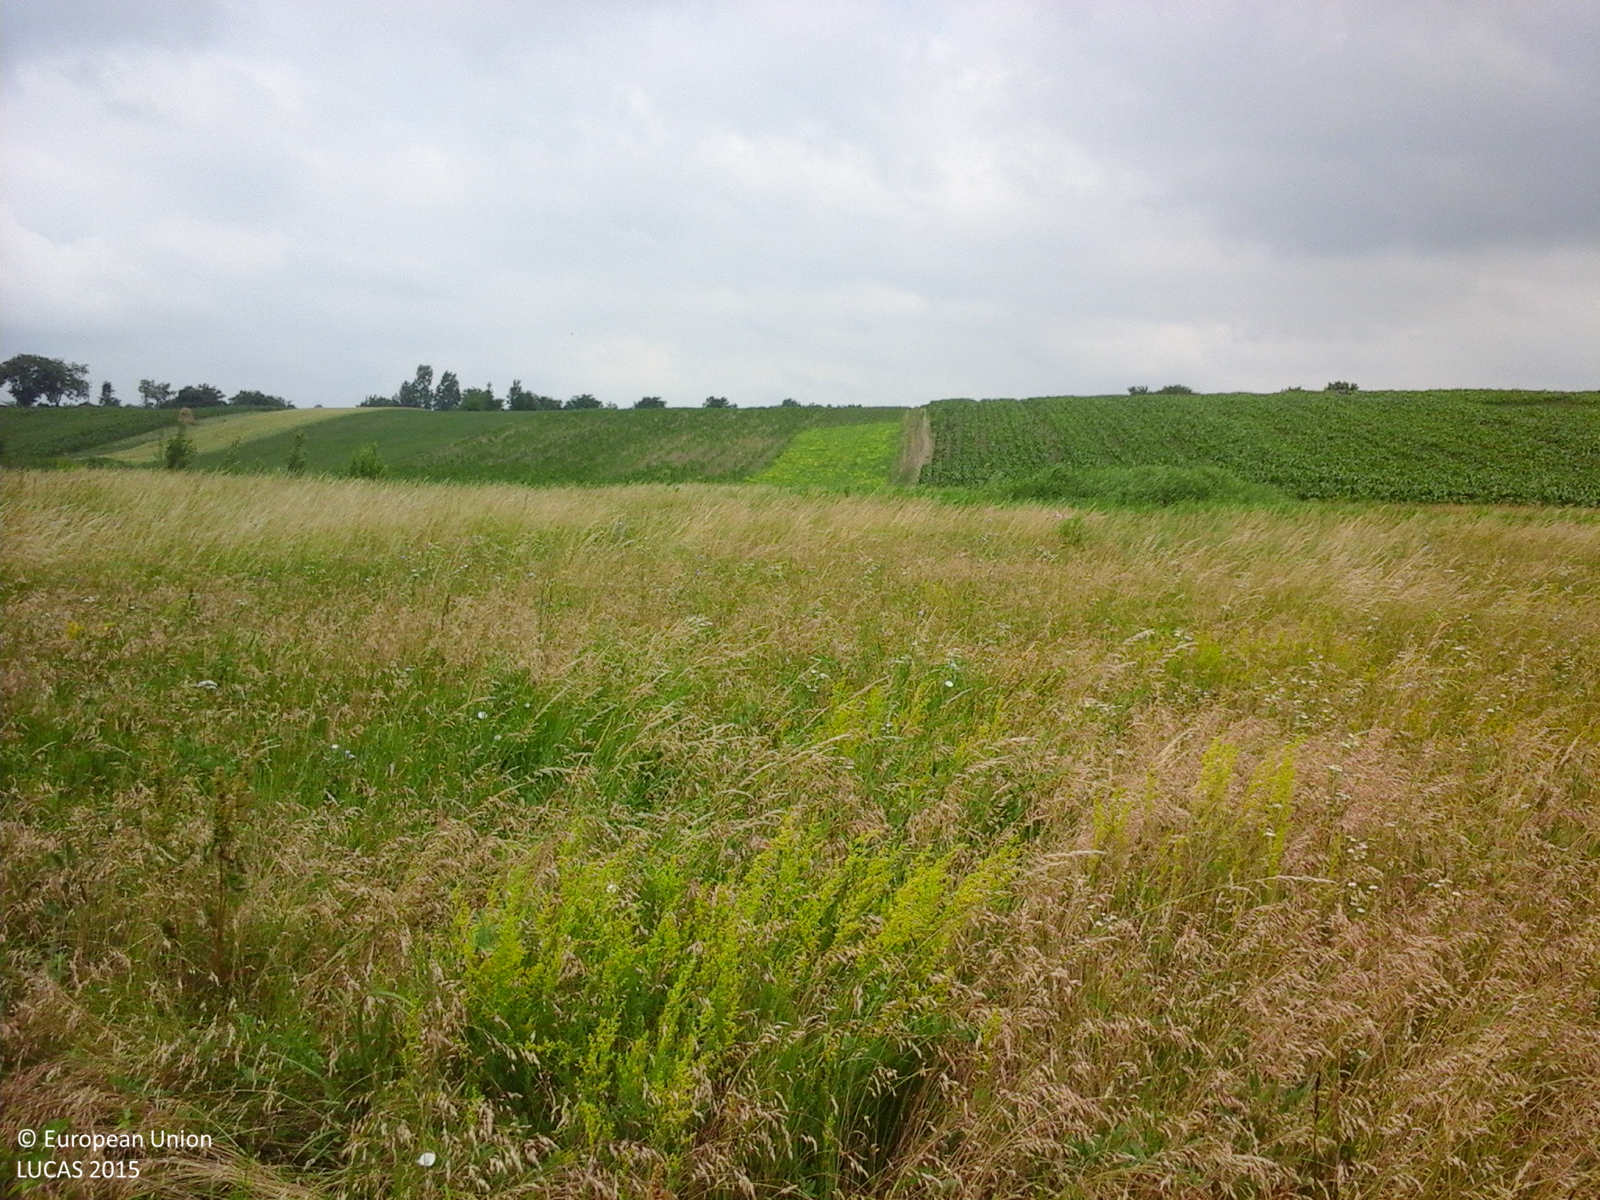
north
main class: Grassland
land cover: Grassland without tree/shrub cover
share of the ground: > 75 %
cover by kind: herbaceous plants 100 %
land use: Agriculture (excluding fallow land and kitchen gardens)
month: June
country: RO
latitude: 48.0506
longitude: 26.3893
